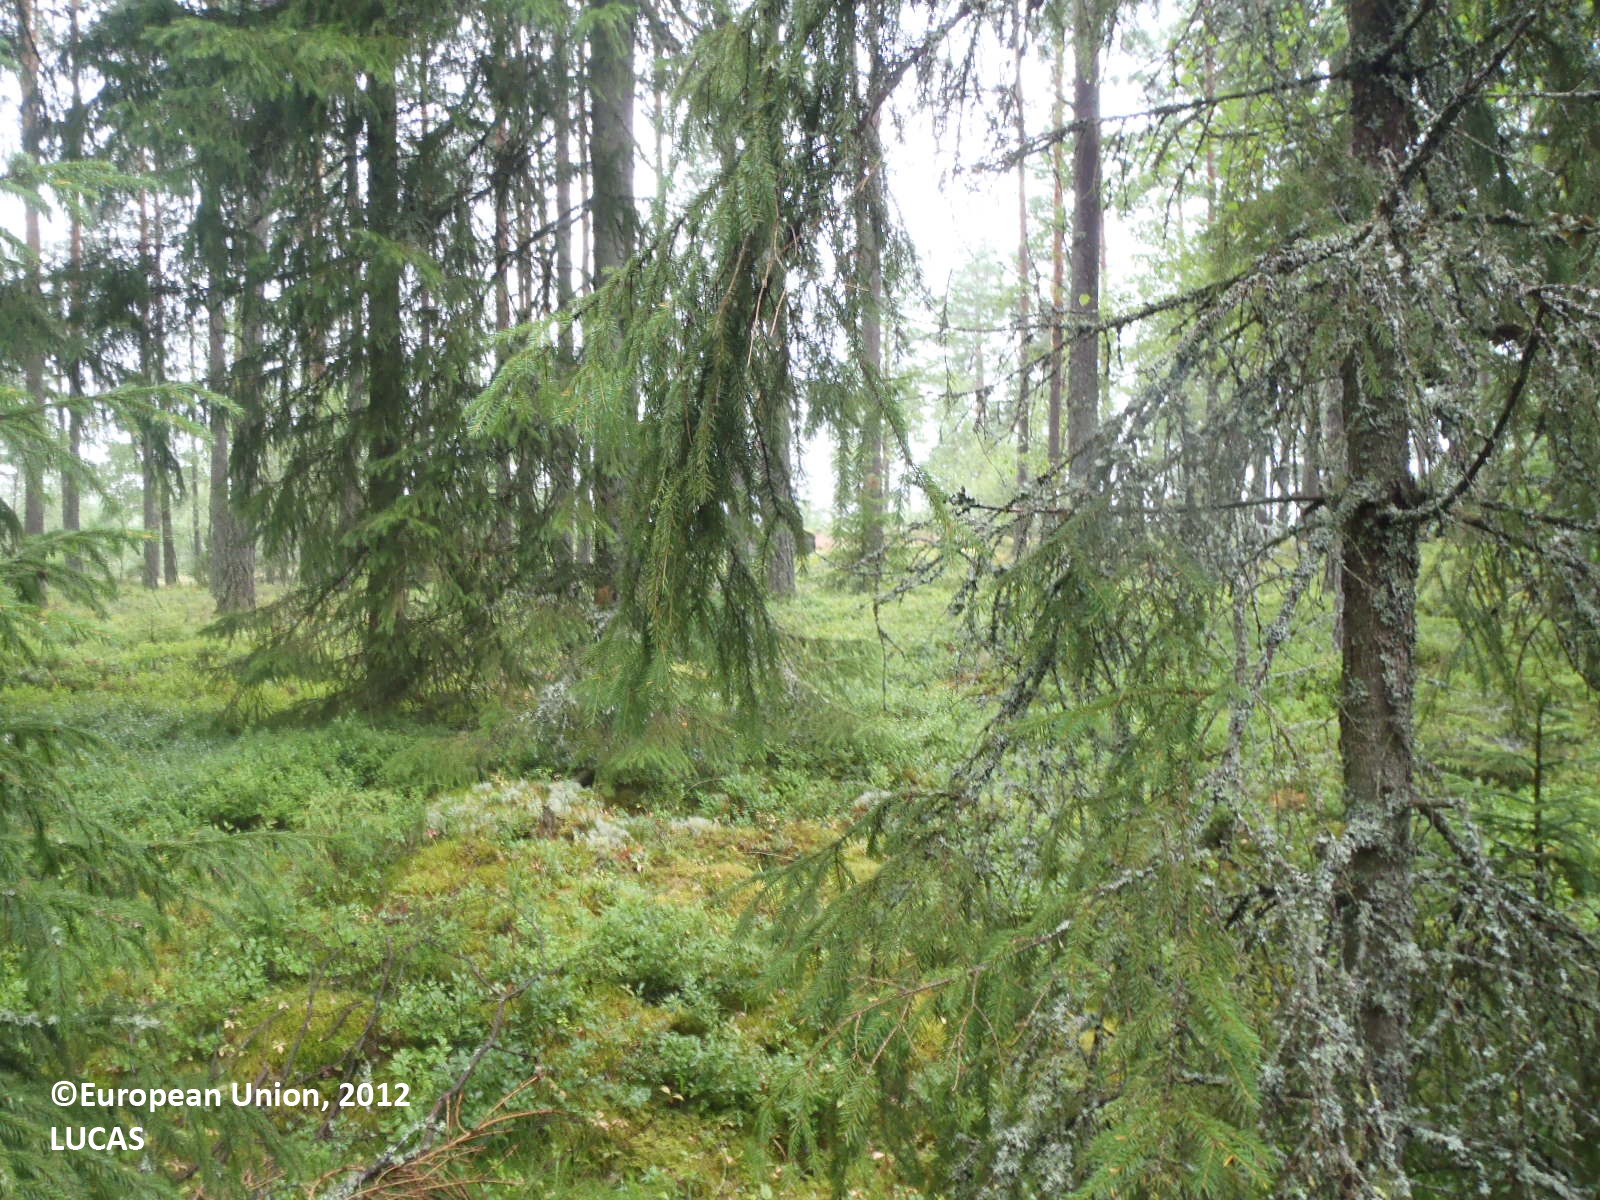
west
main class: Woodland
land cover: Spruce dominated mixed woodland
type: boreal forest
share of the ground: > 75 %
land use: Forestry
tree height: > 5 m
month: July
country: FI
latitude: 60.7457
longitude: 21.7437
